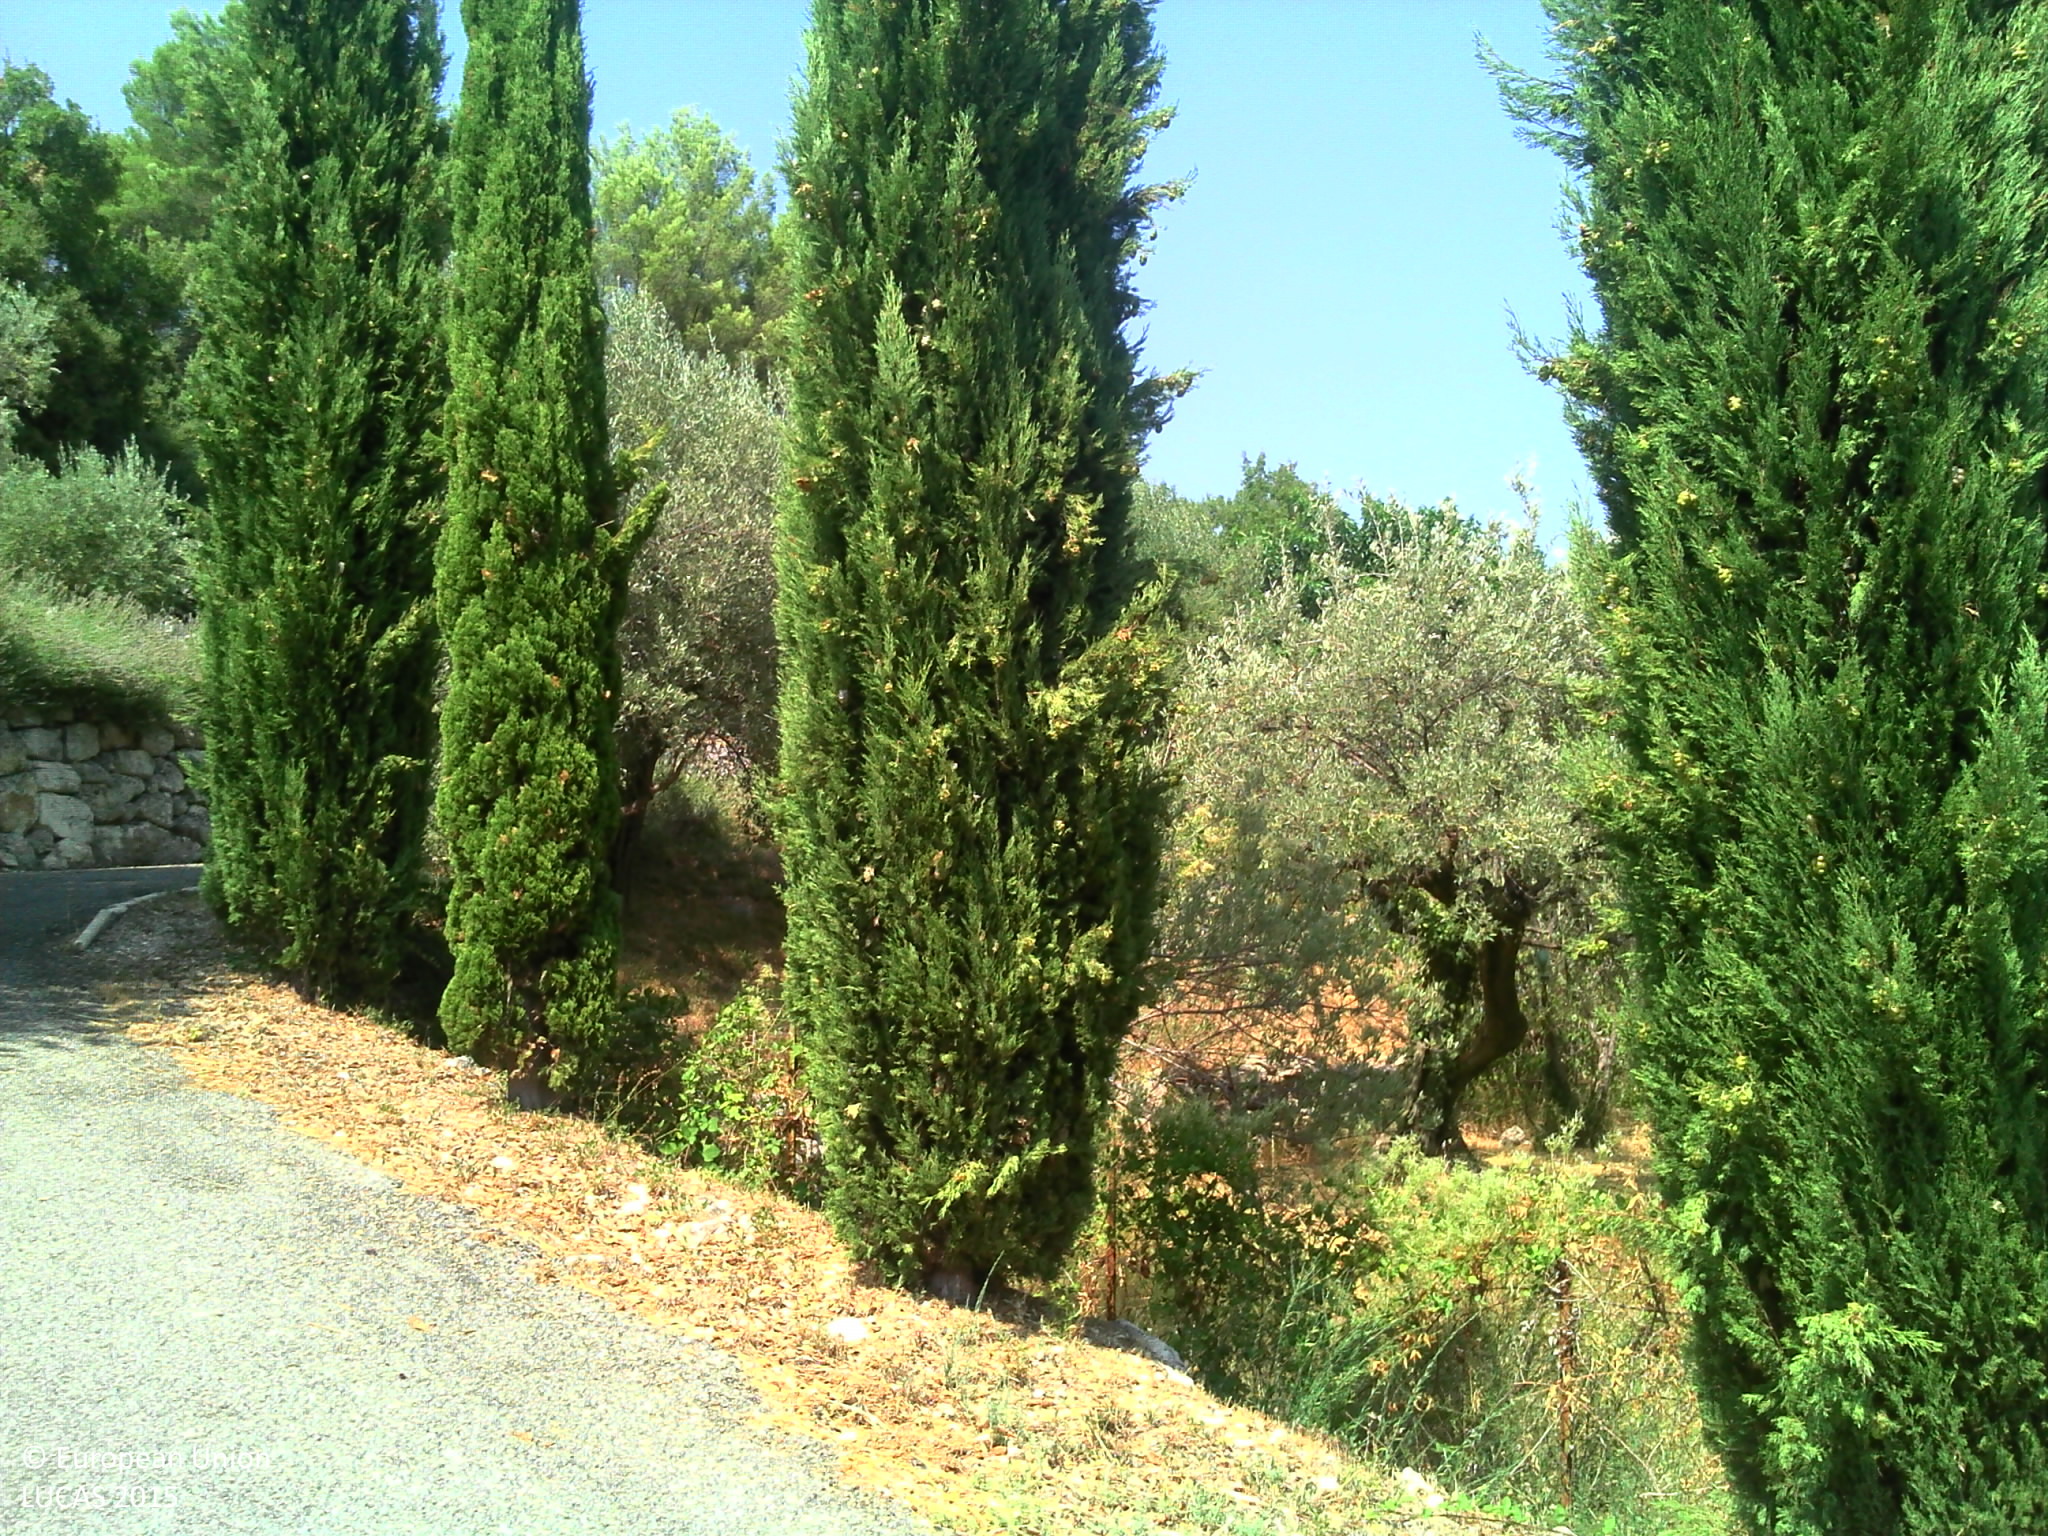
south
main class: Grassland
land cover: Grassland with sparse tree/shrub cover
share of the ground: > 75 %
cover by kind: herbaceous plants 85 %, shrubs 10 %, coniferous forest trees 5 %
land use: Residential
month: August
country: FR
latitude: 43.5694
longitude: 6.5043
